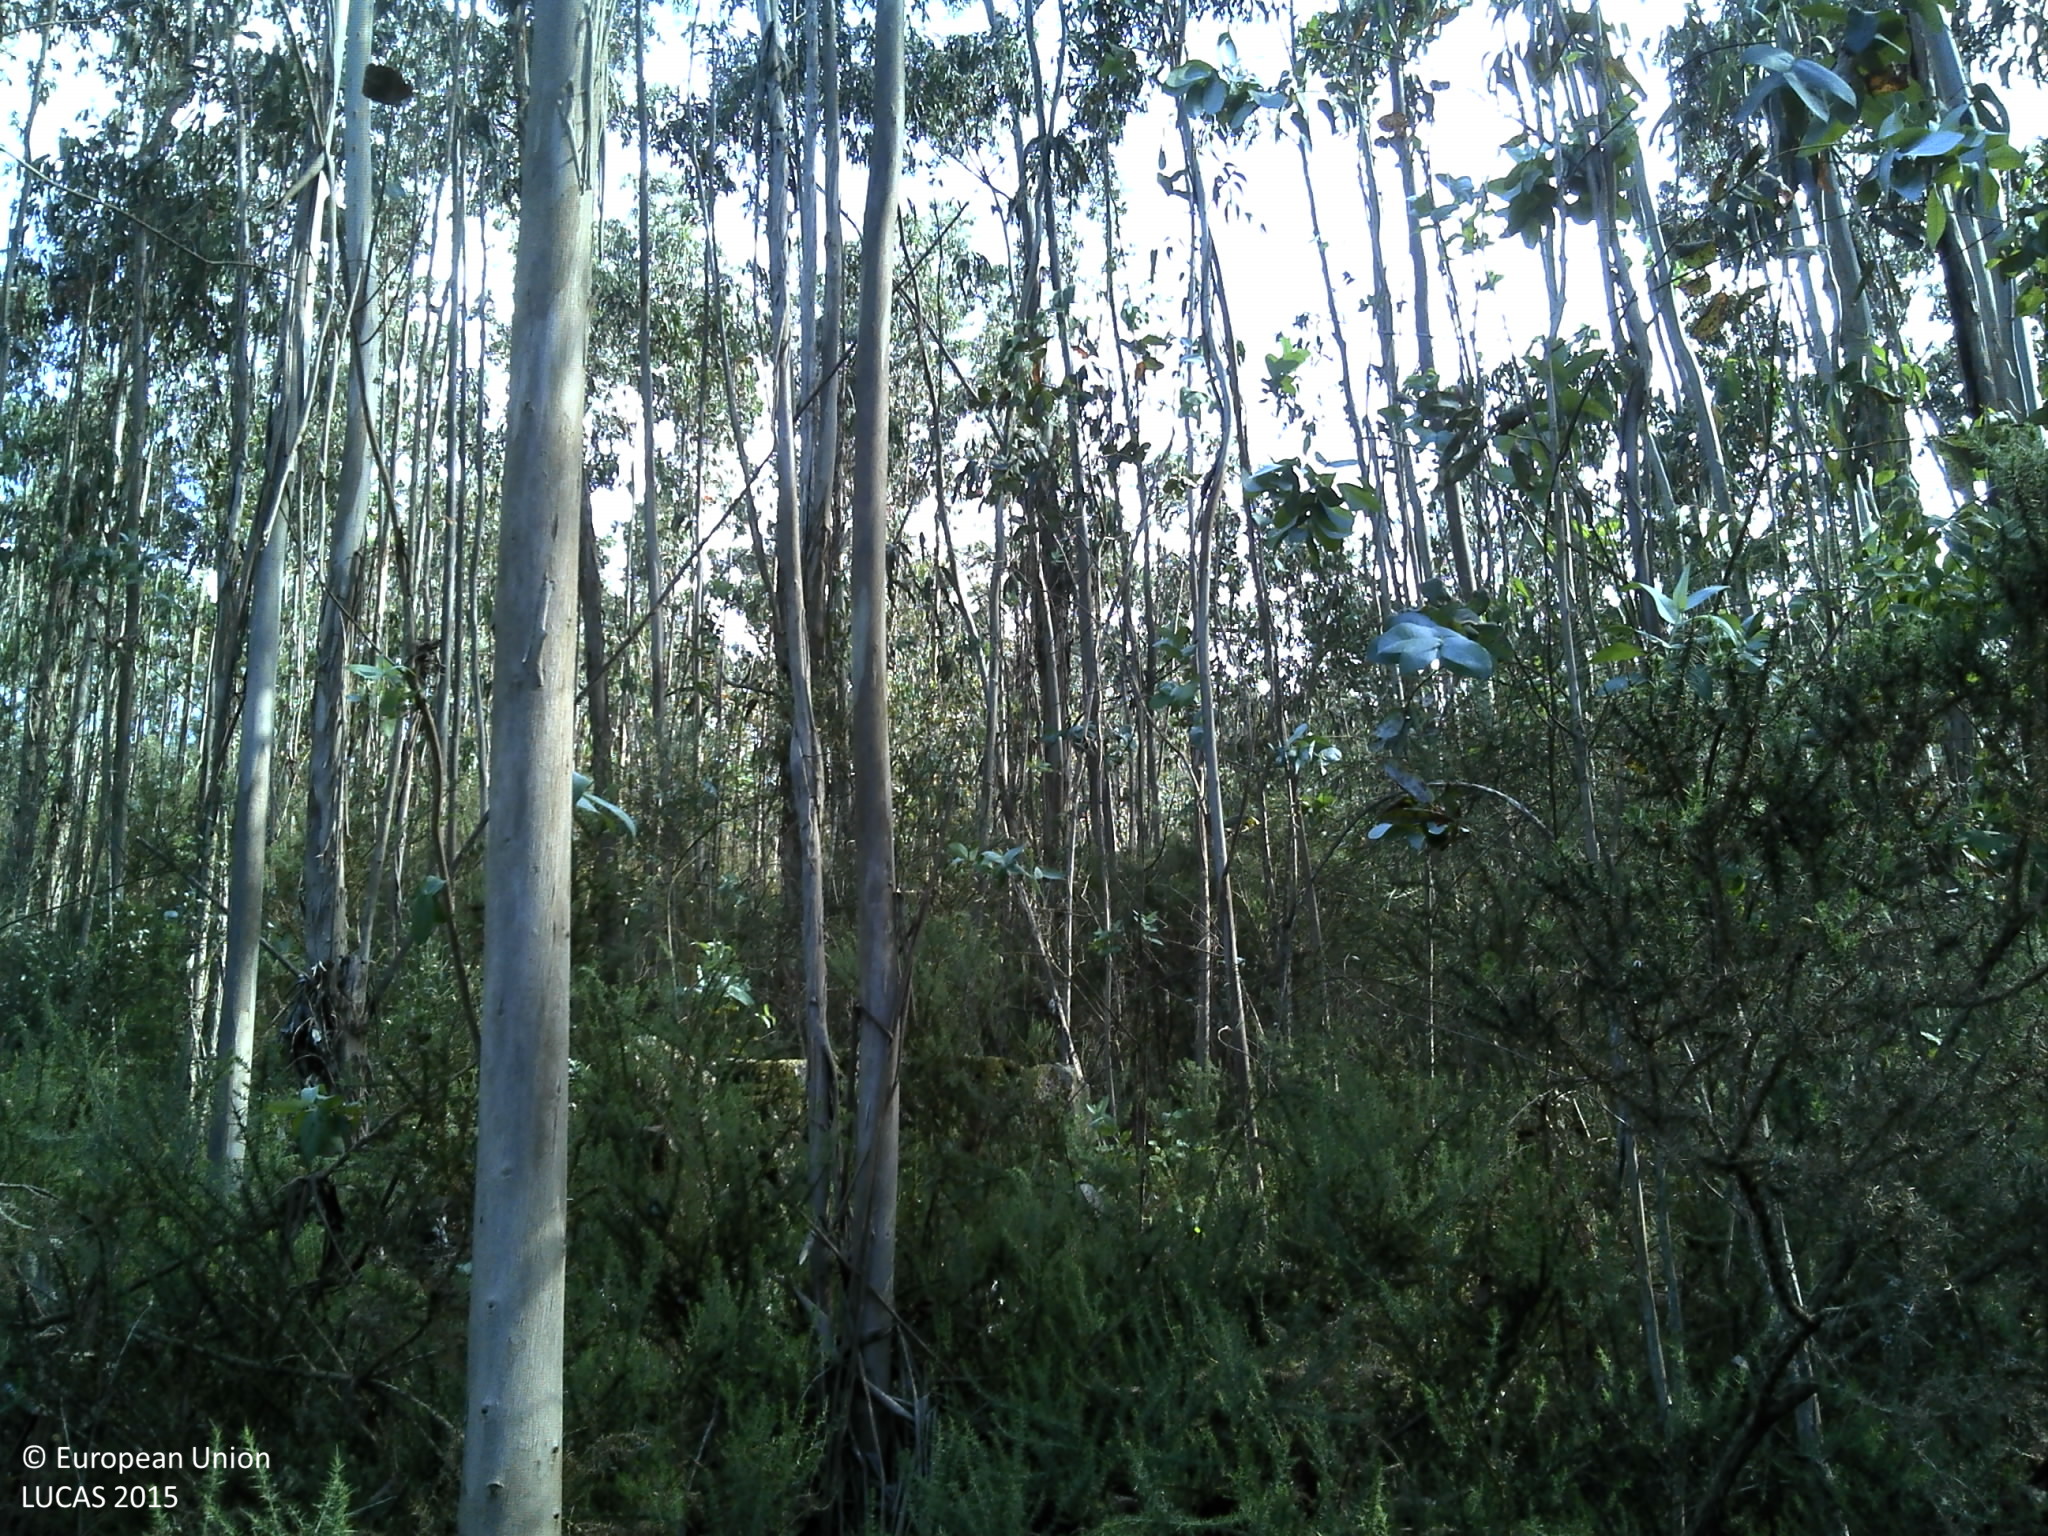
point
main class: Woodland
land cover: Broadleaved woodland
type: exotic forest
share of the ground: 50 - 75 %
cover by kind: broadleaved forest trees 80 %, shrubs 20 %
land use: Forestry
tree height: > 5 m
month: May
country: PT
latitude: 41.6840
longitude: -8.7261
